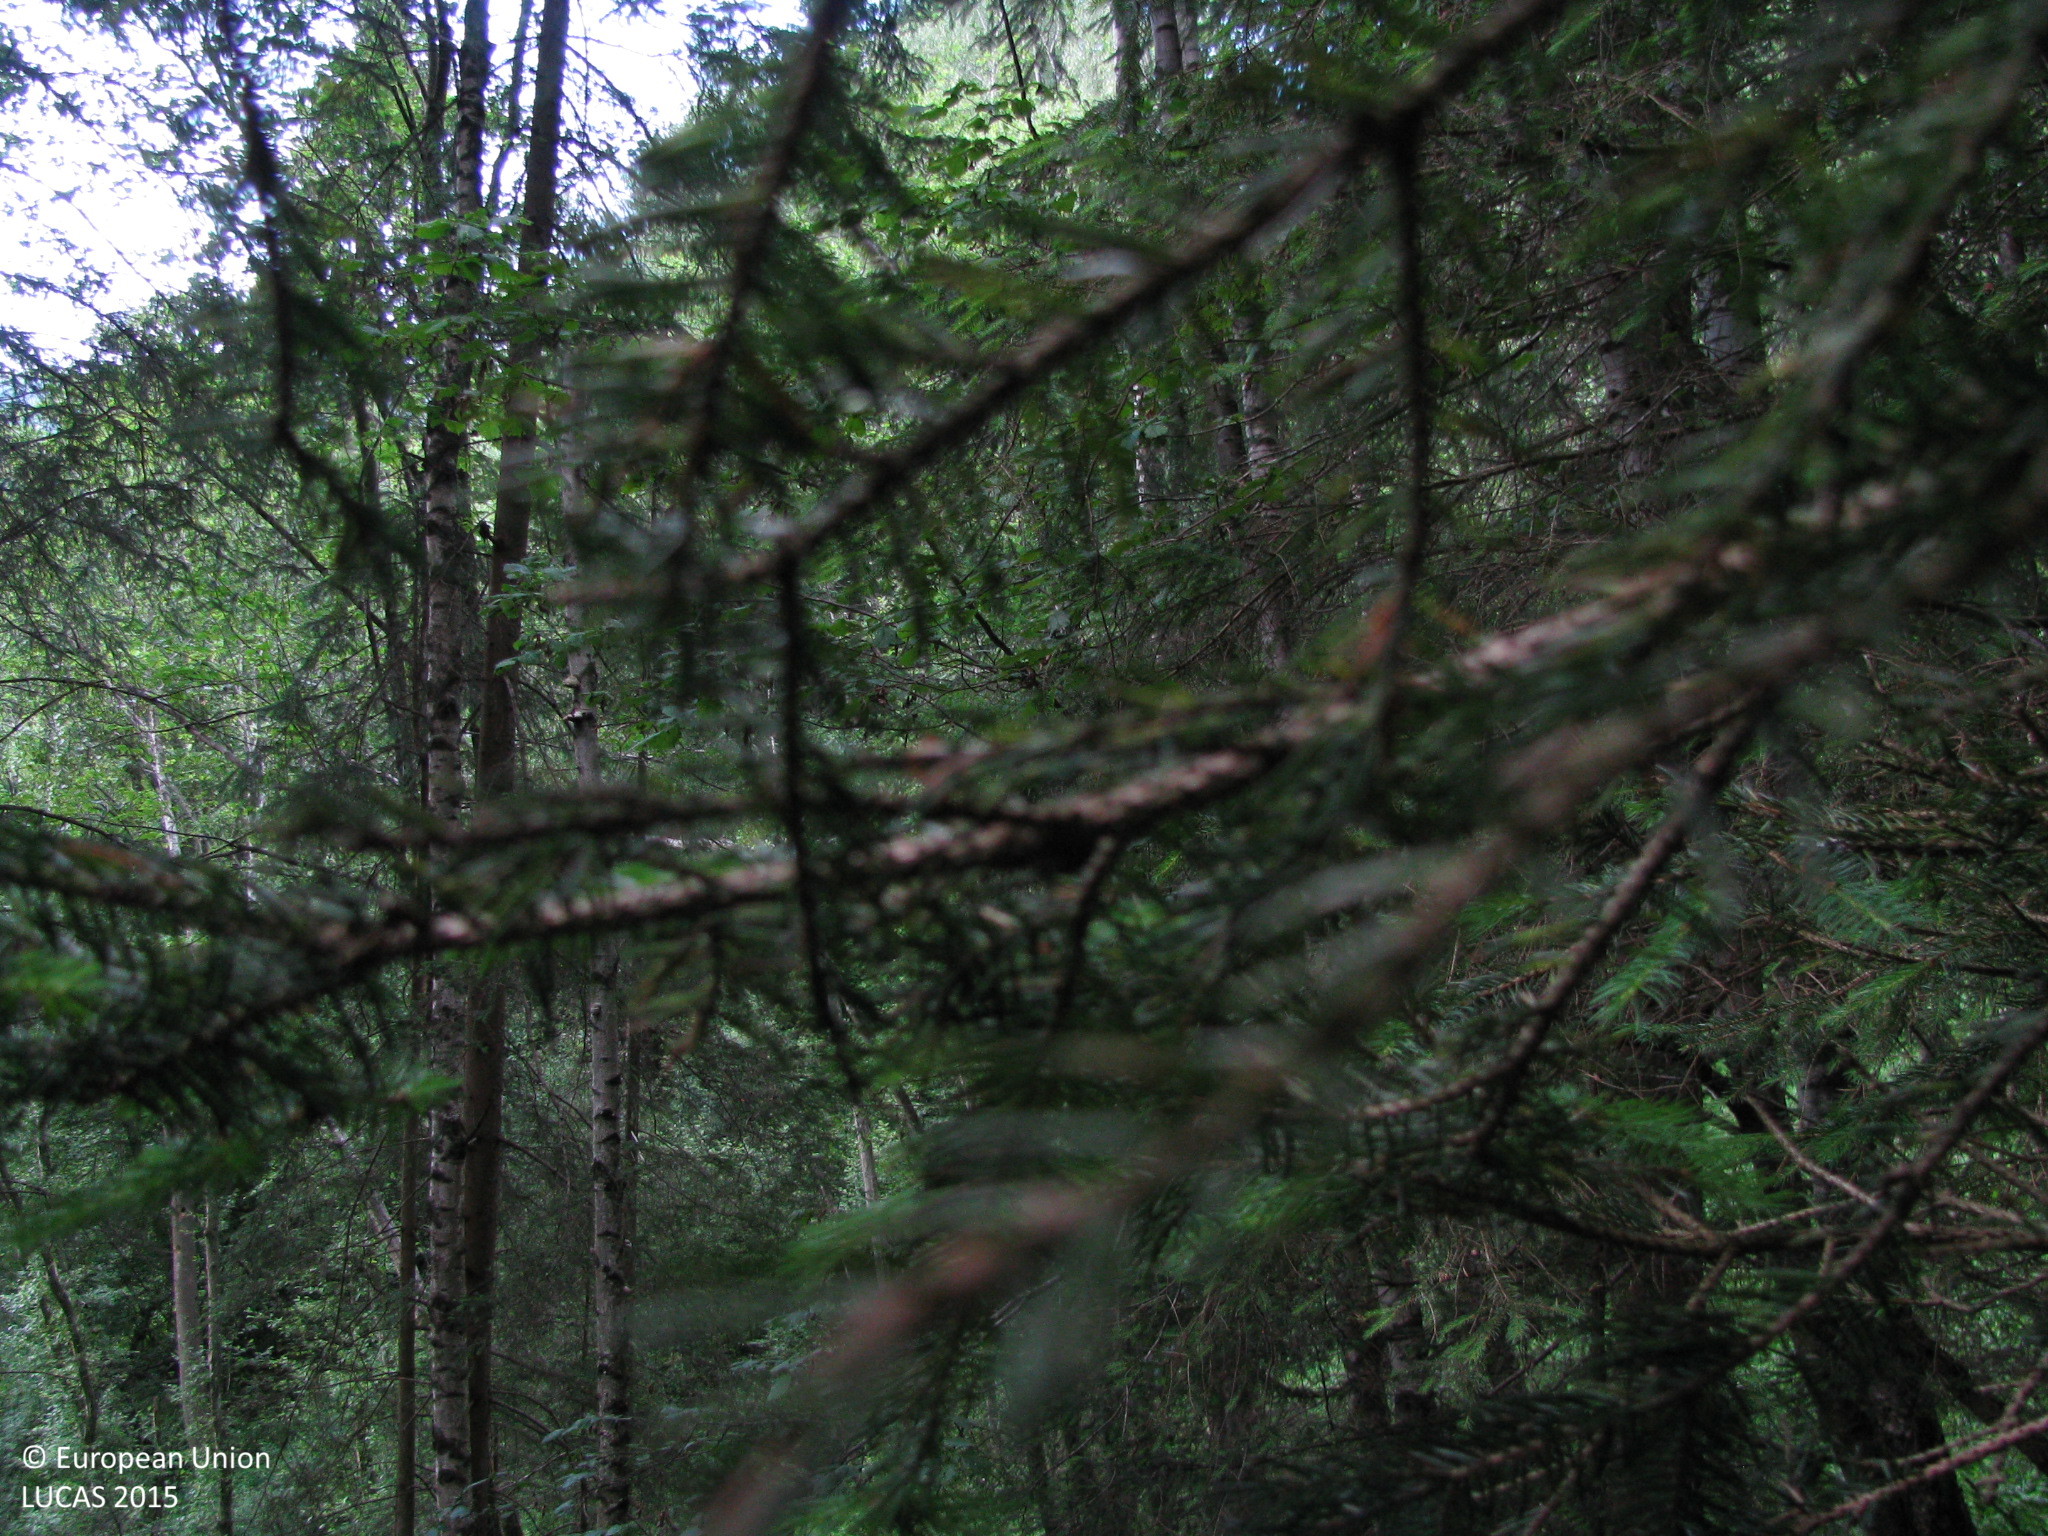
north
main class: Woodland
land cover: Spruce dominated mixed woodland
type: mire and swamp forests
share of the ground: 50 - 75 %
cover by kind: coniferous forest trees 35 %, broadleaved forest trees 35 %, herbaceous plants 30 %
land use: Forestry
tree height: > 5 m
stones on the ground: < 10 %
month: June
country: AT
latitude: 47.2427
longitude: 14.6359
